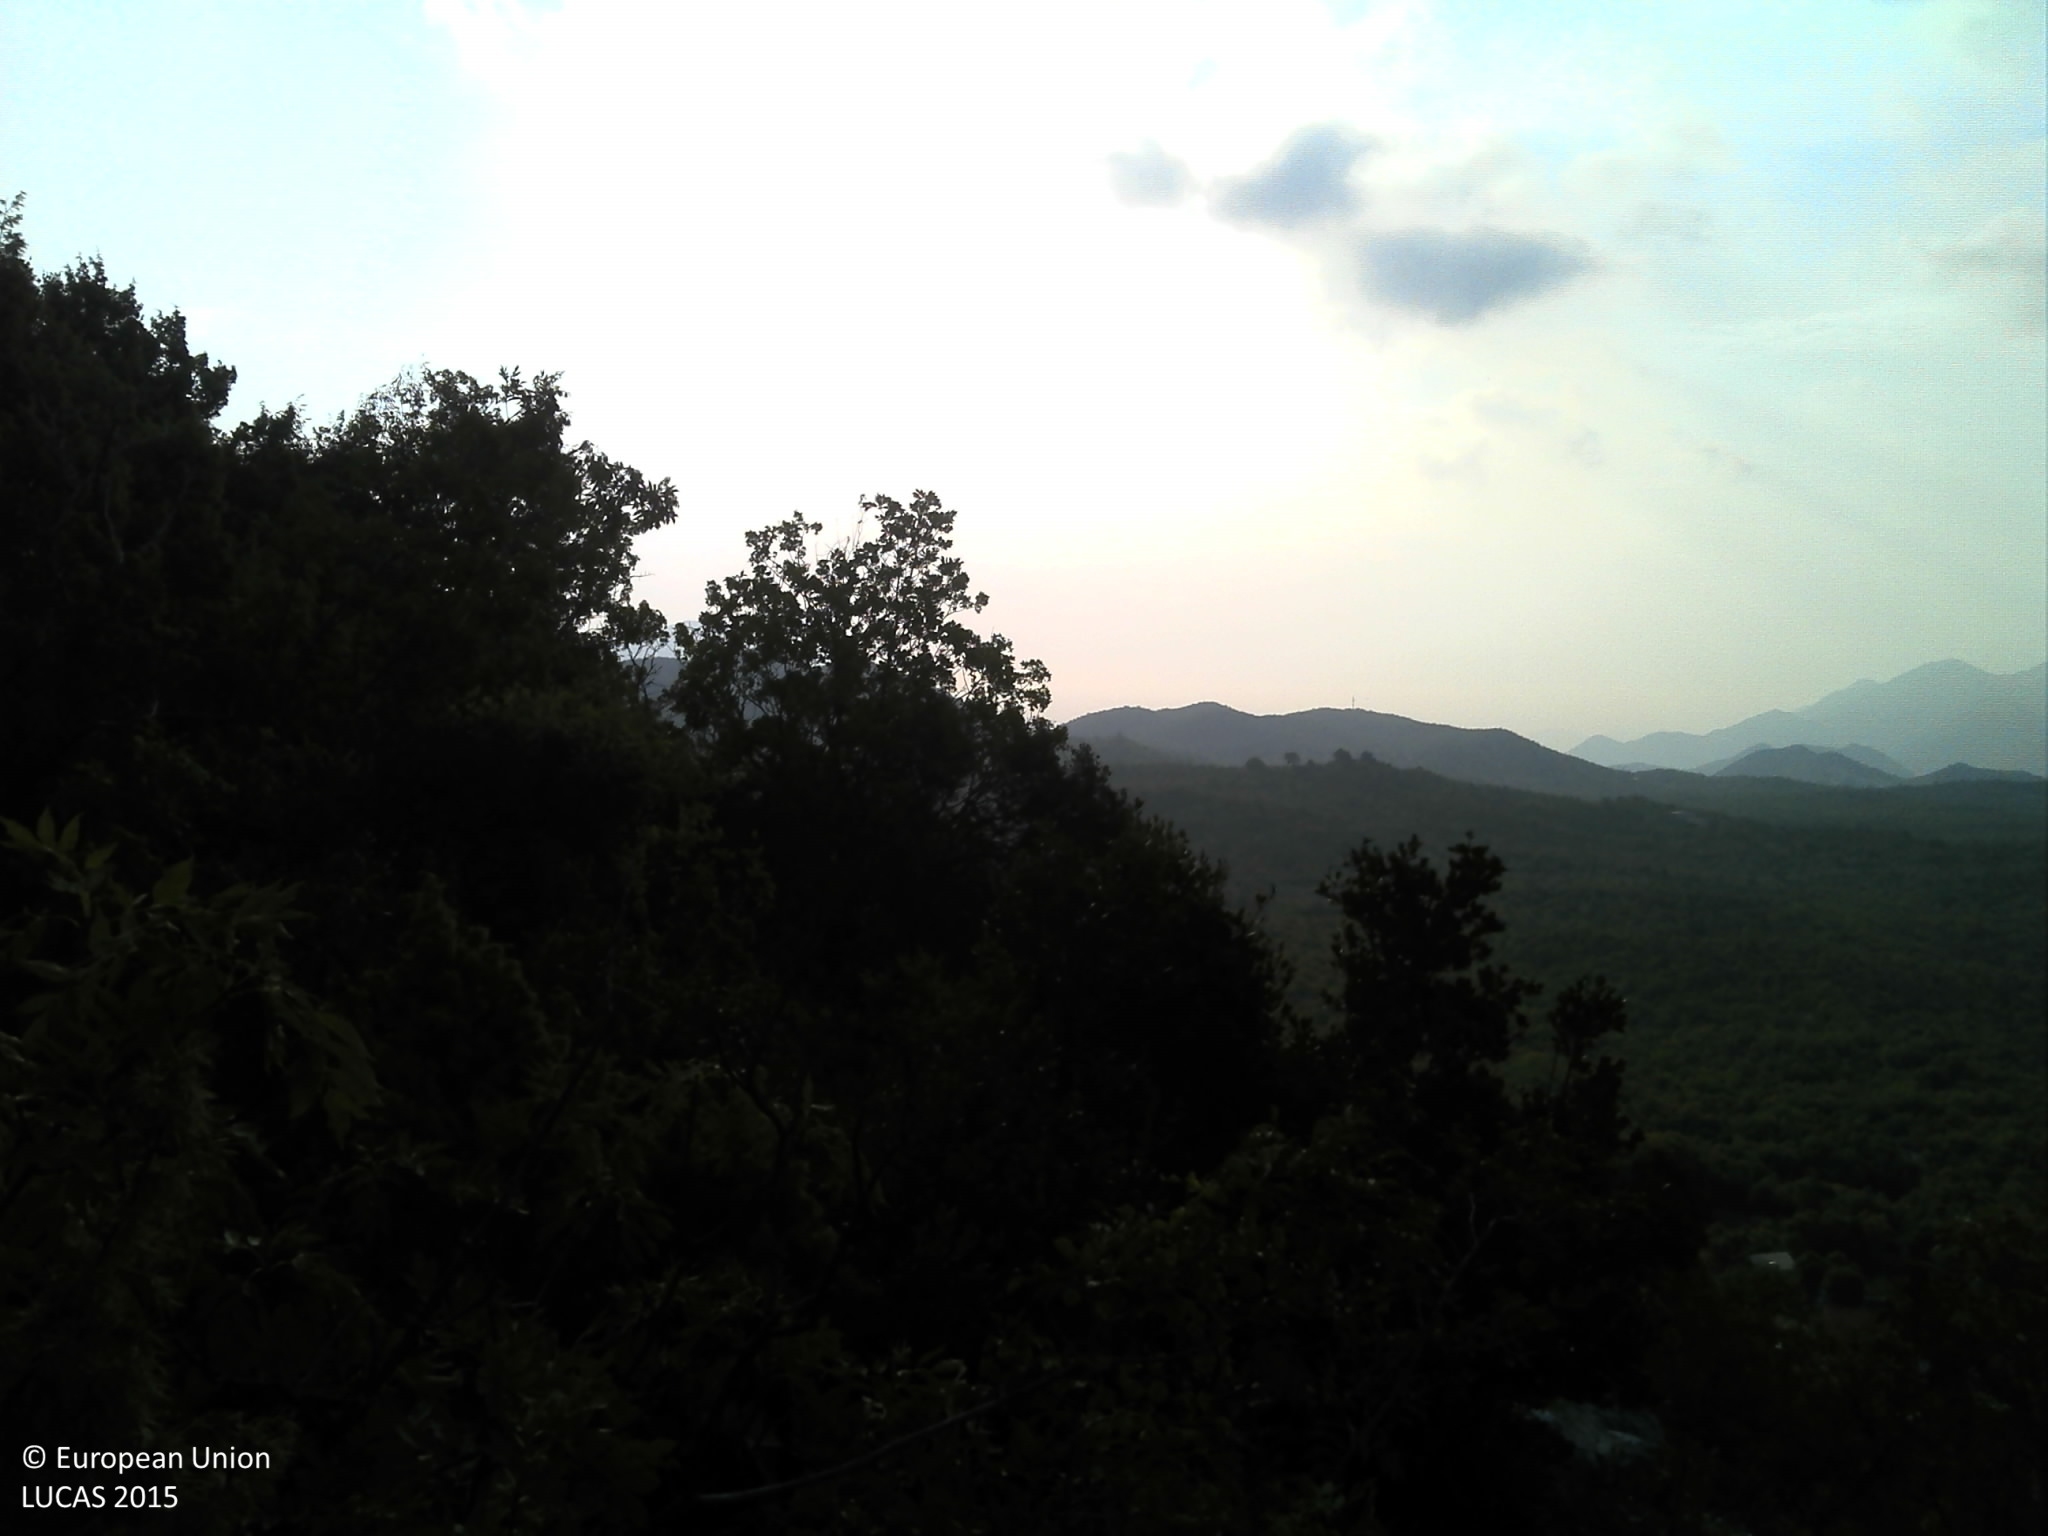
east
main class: Shrubland
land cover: Shrubland with sparse tree cover
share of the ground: > 75 %
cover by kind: shrubs 65 %, unconsolidated bare surface 15 %, consolidated bare surface 10 %, broadleaved forest trees 5 %, herbaceous plants 5 %
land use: Semi-natural and natural areas not in use
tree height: < 5 m
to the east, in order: Shrubland with sparse tree cover; Rock outcrops; Shrubland with sparse tree cover; Dry stone walls; Shrubland with sparse tree cover; Dry stone walls; Olive groves; Dry stone walls; Olive groves; Dry stone walls; Apple fruit; Dry stone walls; Tracks; Dry stone walls; Grassland with sparse tree/shrub cover; Dry stone walls
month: August
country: HR
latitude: 43.2118
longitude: 17.2163
